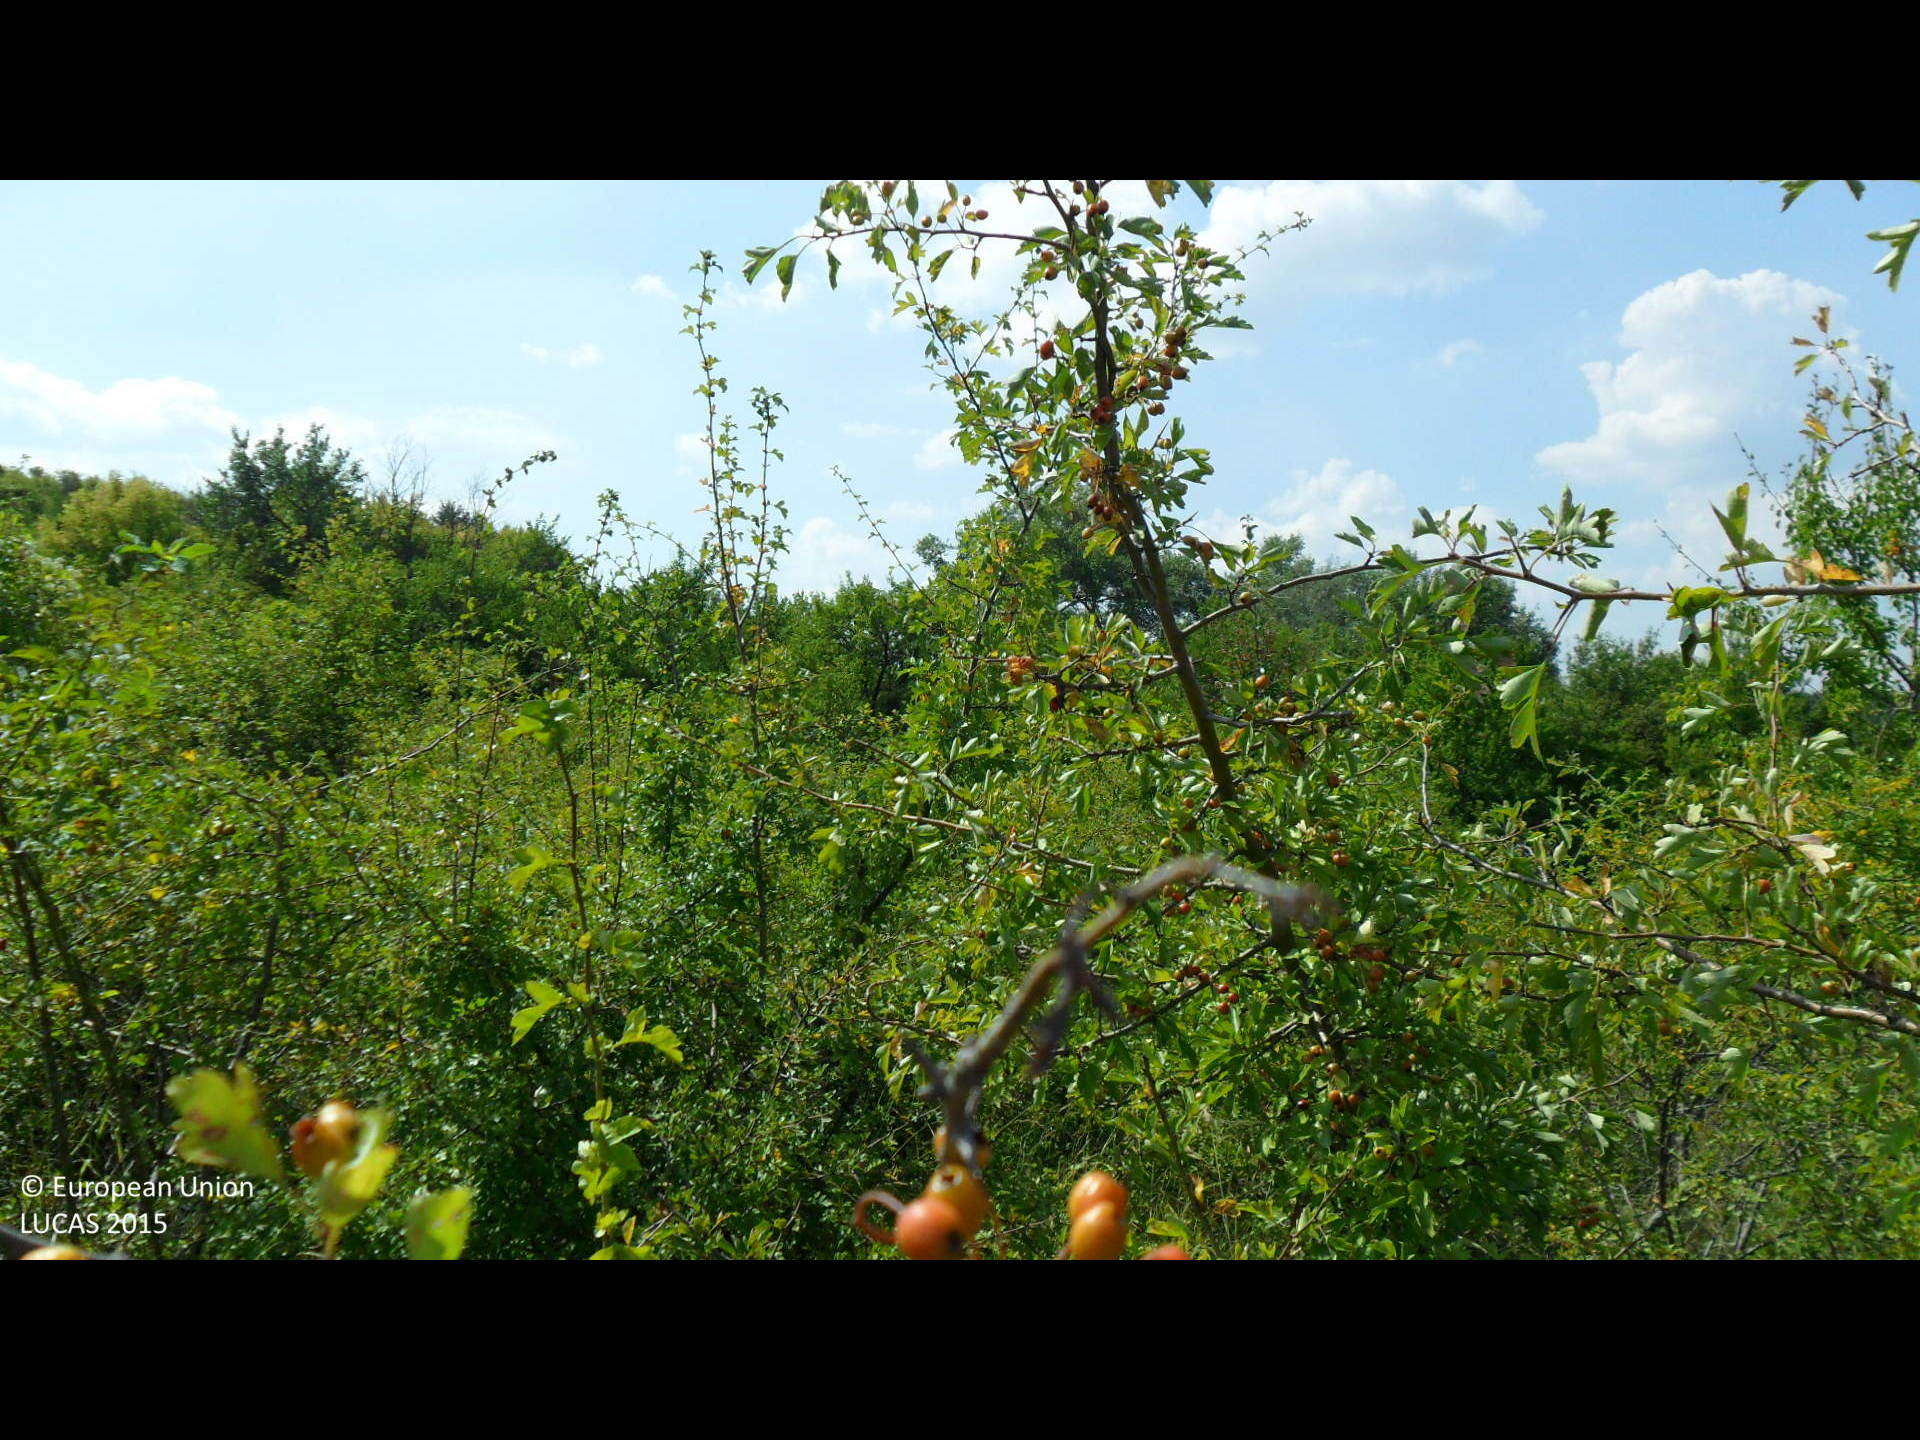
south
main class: Shrubland
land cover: Shrubland with sparse tree cover
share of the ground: > 75 %
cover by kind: shrubs 90 %, broadleaved forest trees 5 %, herbaceous plants 5 %
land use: Semi-natural and natural areas not in use
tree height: < 5 m
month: August
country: BG
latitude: 43.2854
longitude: 26.3285
